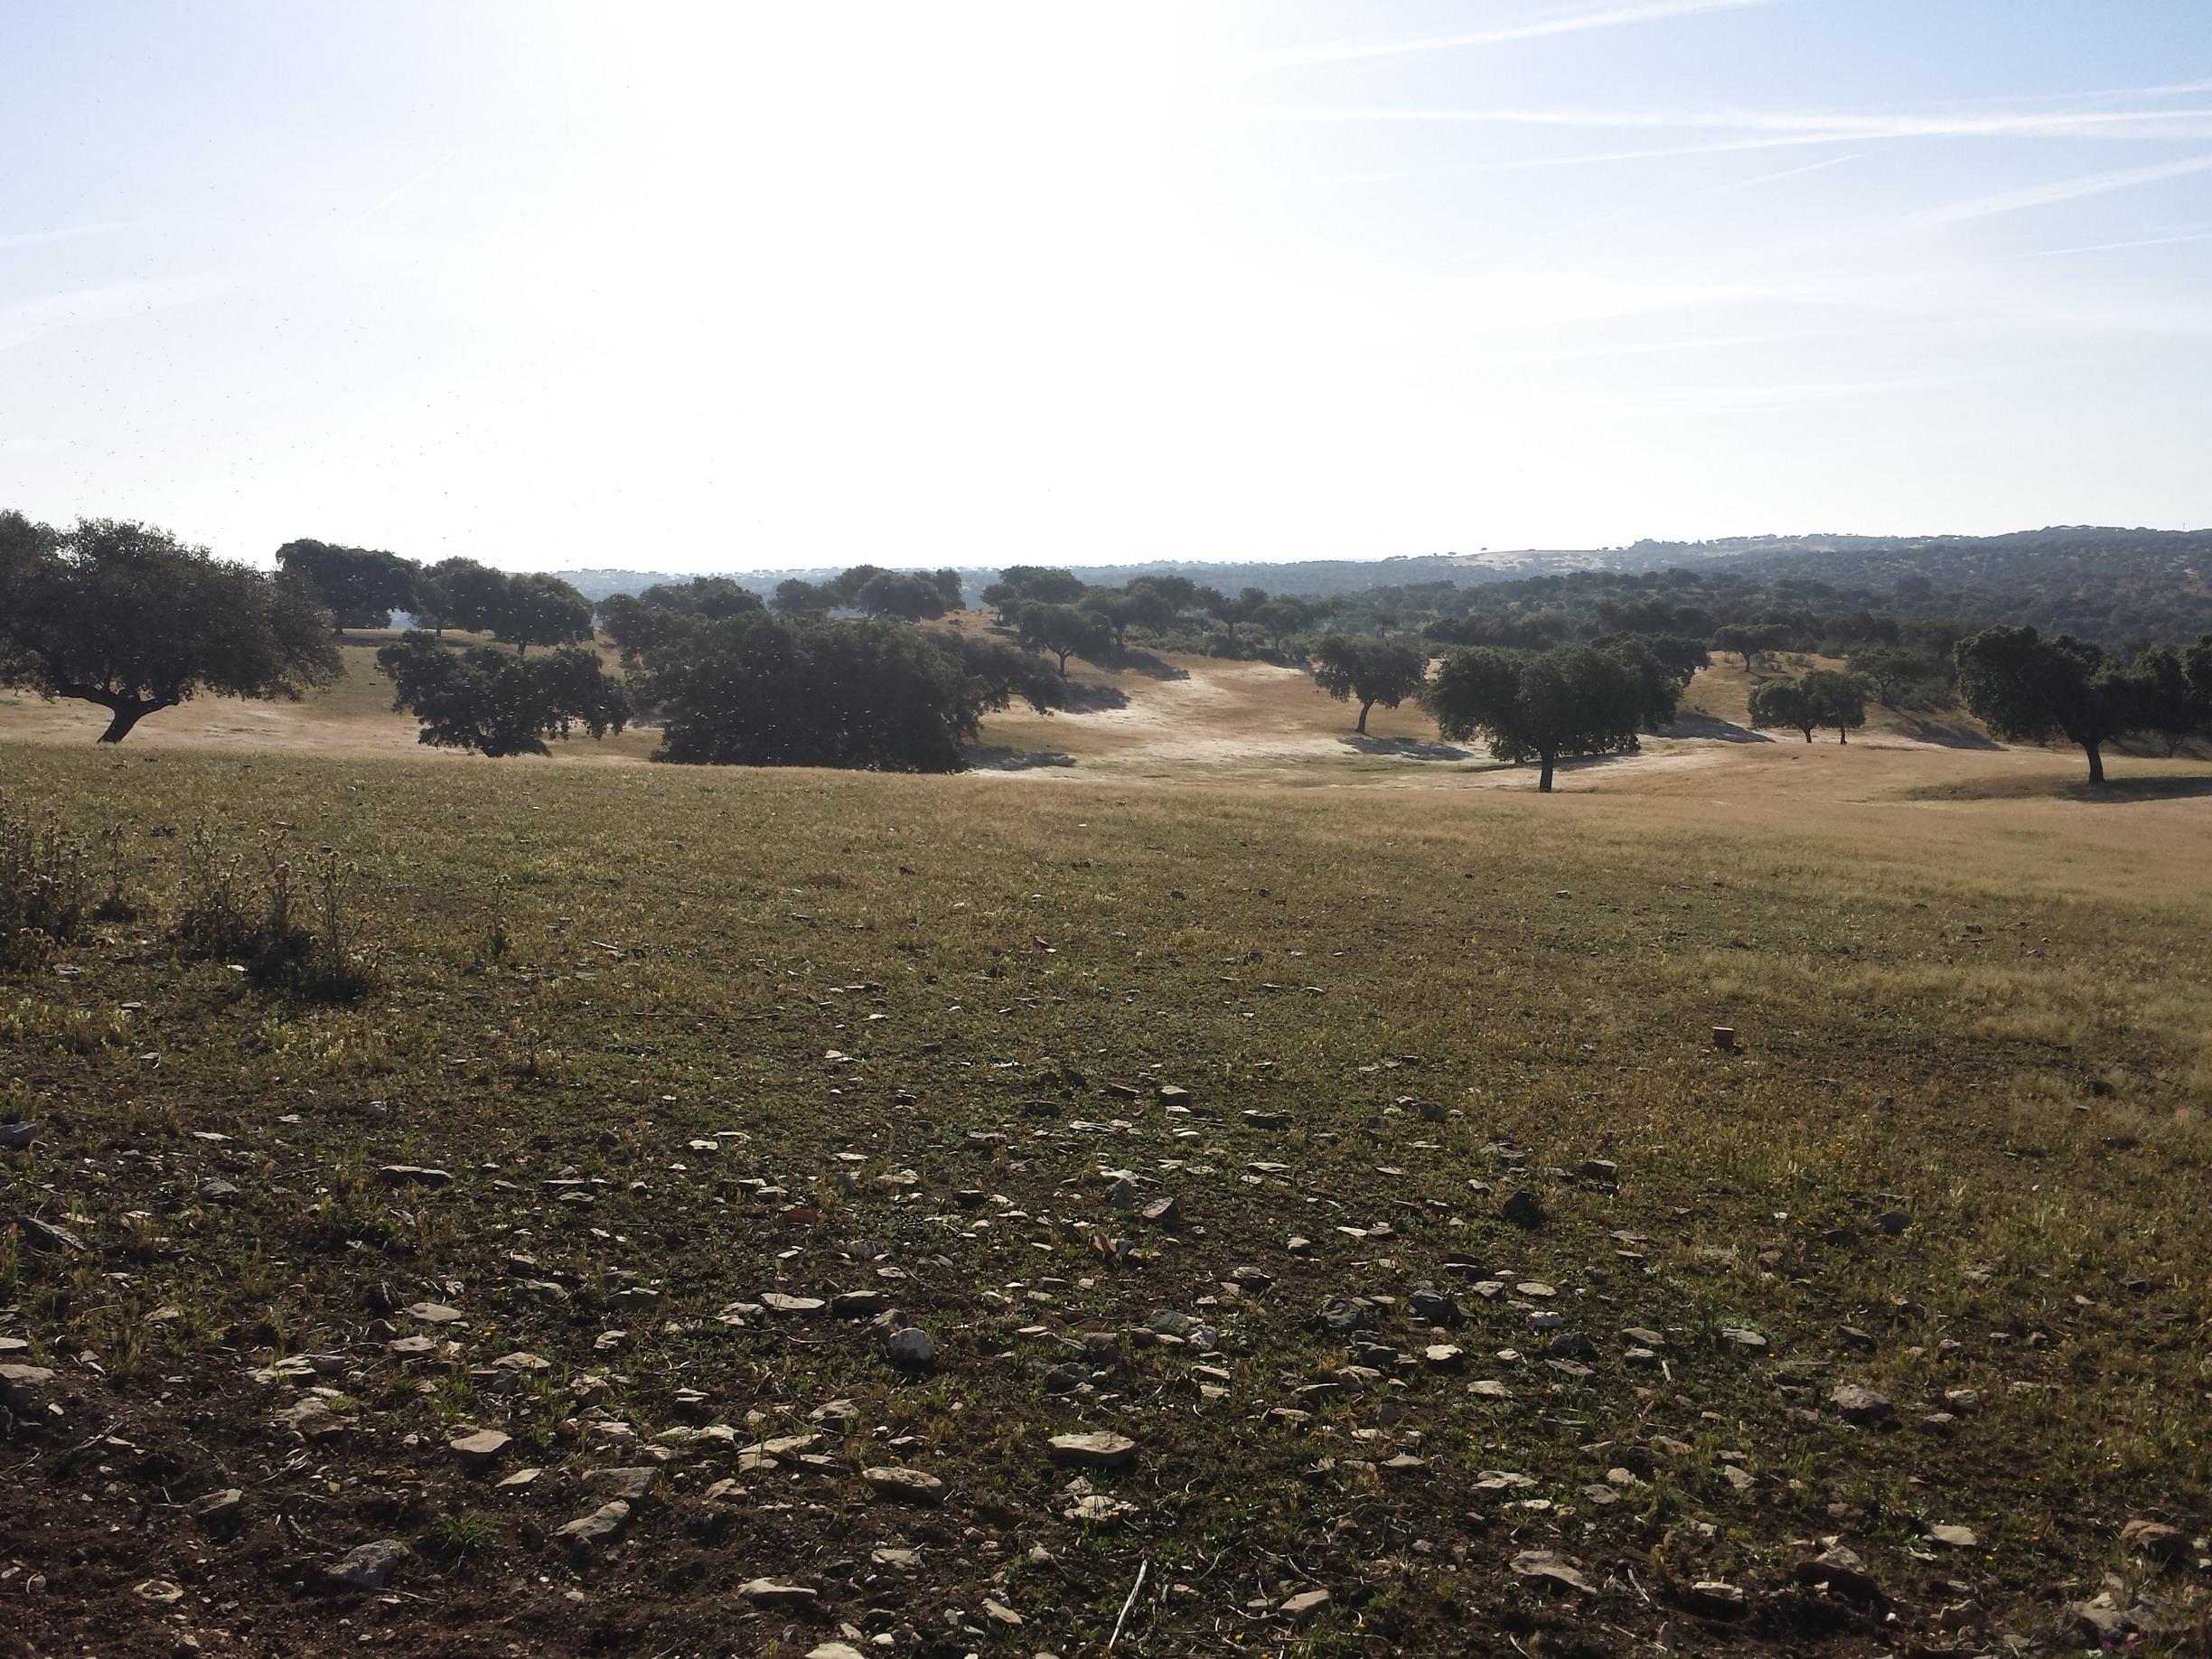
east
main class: Grassland
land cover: Grassland with sparse tree/shrub cover
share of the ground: > 75 %
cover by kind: herbaceous plants 90 %, broadleaved forest trees 5 %
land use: Agriculture (excluding fallow land and kitchen gardens)
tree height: > 5 m
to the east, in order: Grassland with sparse tree/shrub cover; Broadleaved woodland
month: May
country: ES
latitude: 39.6384
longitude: -7.2058
